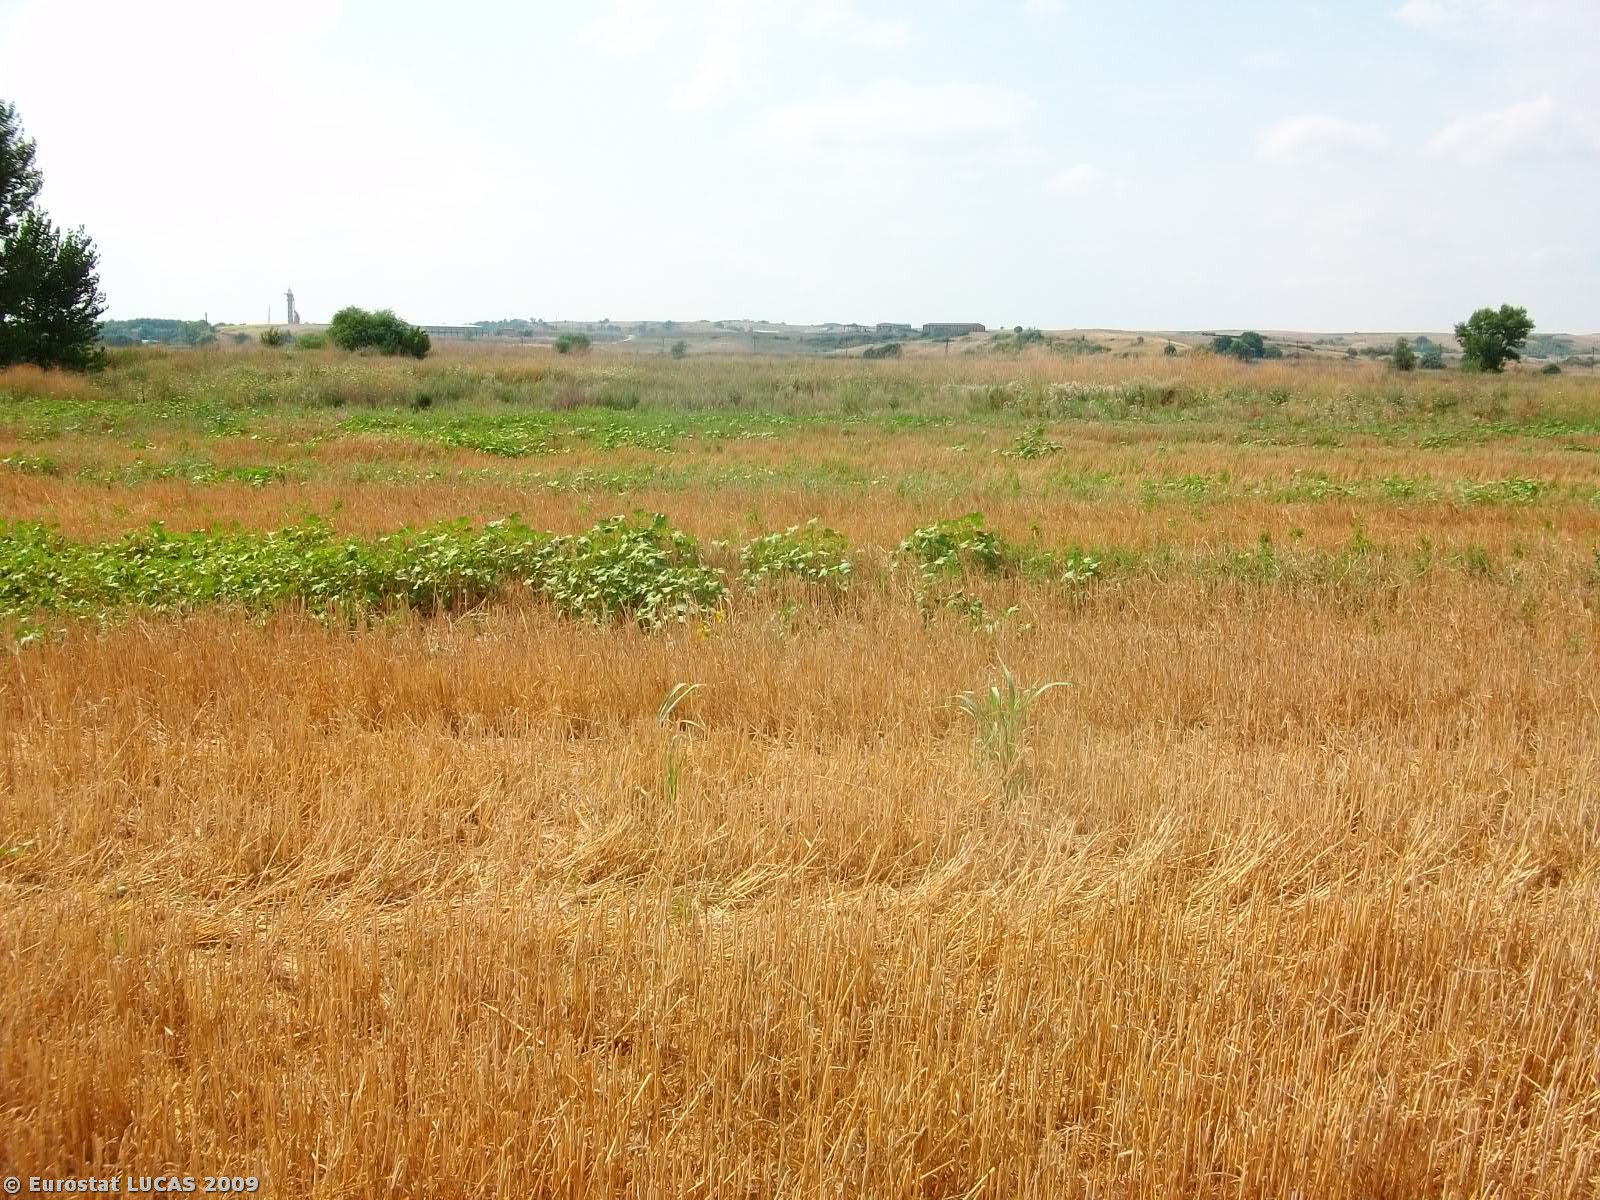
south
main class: Cropland
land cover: Triticale
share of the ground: < 10 %
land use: Agriculture (excluding fallow land and kitchen gardens)
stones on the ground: < 10 %
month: August
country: GR
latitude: 41.4882
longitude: 26.5240
